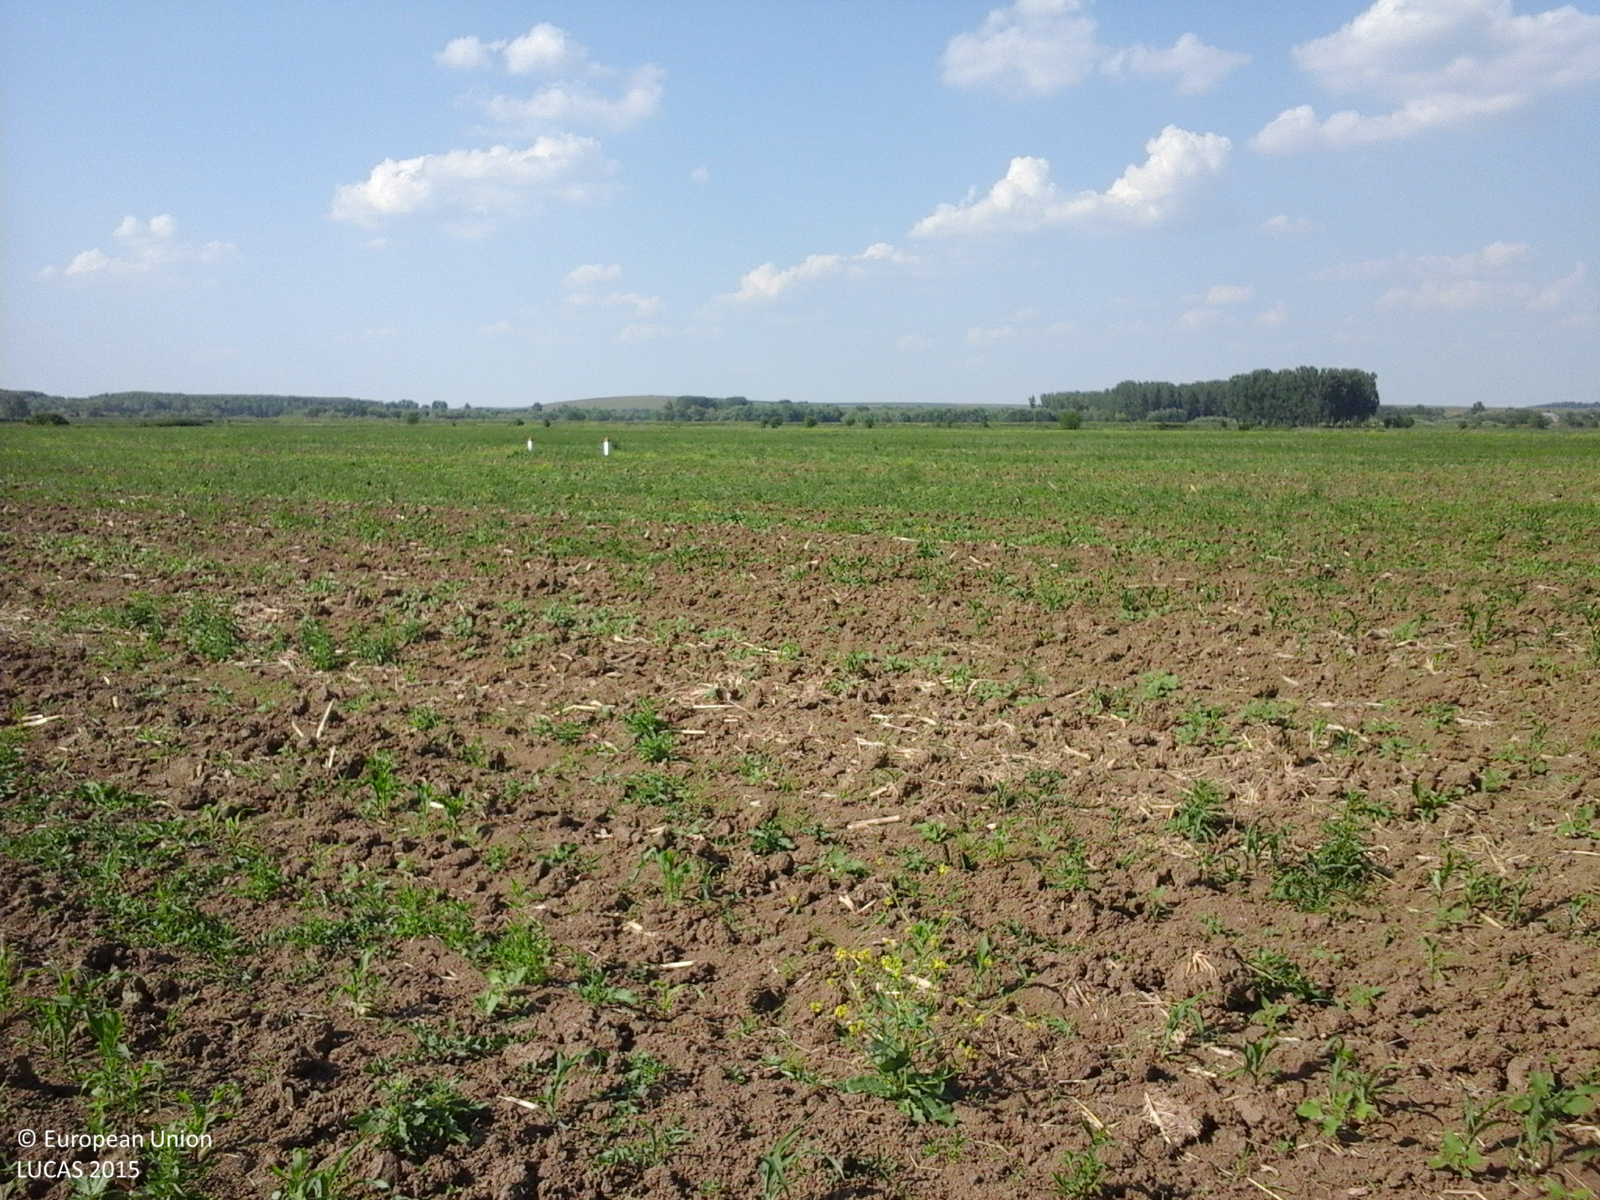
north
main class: Cropland
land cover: Maize
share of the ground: > 75 %
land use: Agriculture (excluding fallow land and kitchen gardens)
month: June
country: RO
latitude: 47.0734
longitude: 26.8876
